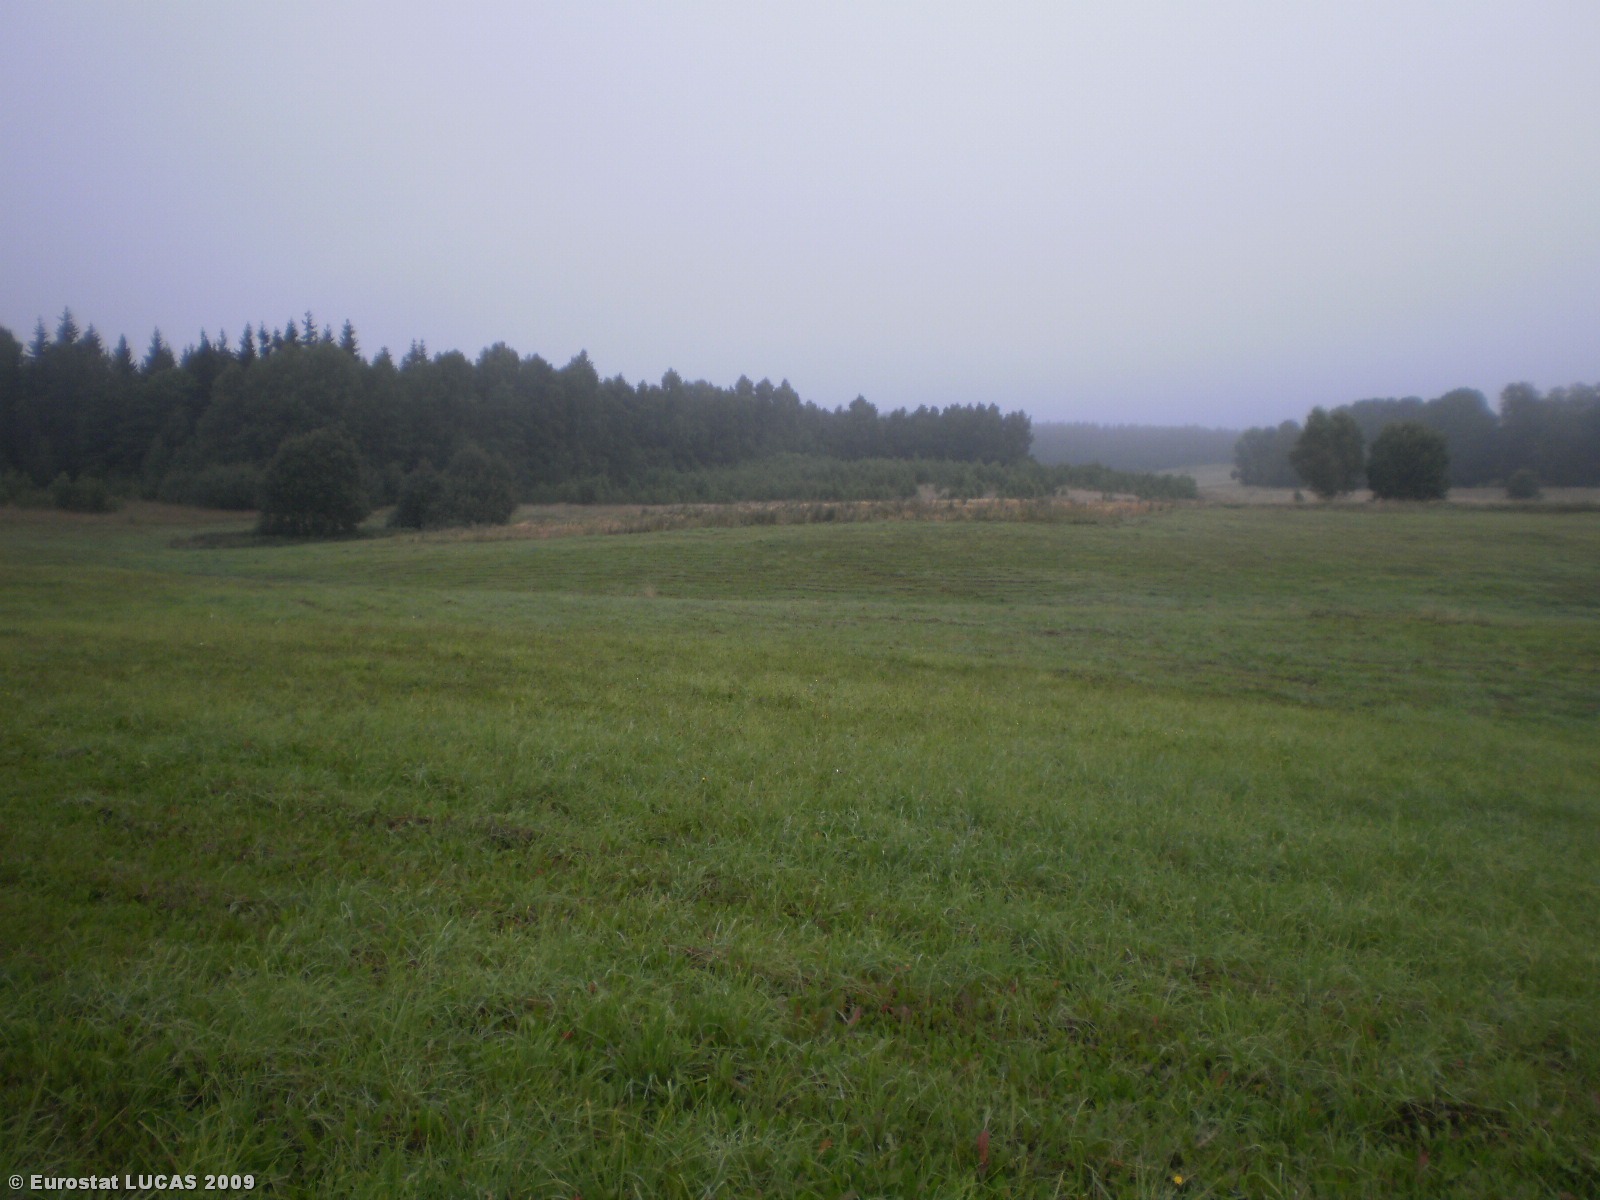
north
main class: Grassland
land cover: Grassland without tree/shrub cover
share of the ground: > 75 %
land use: Agriculture (excluding fallow land and kitchen gardens)
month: August
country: LT
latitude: 55.3397
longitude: 25.5621
